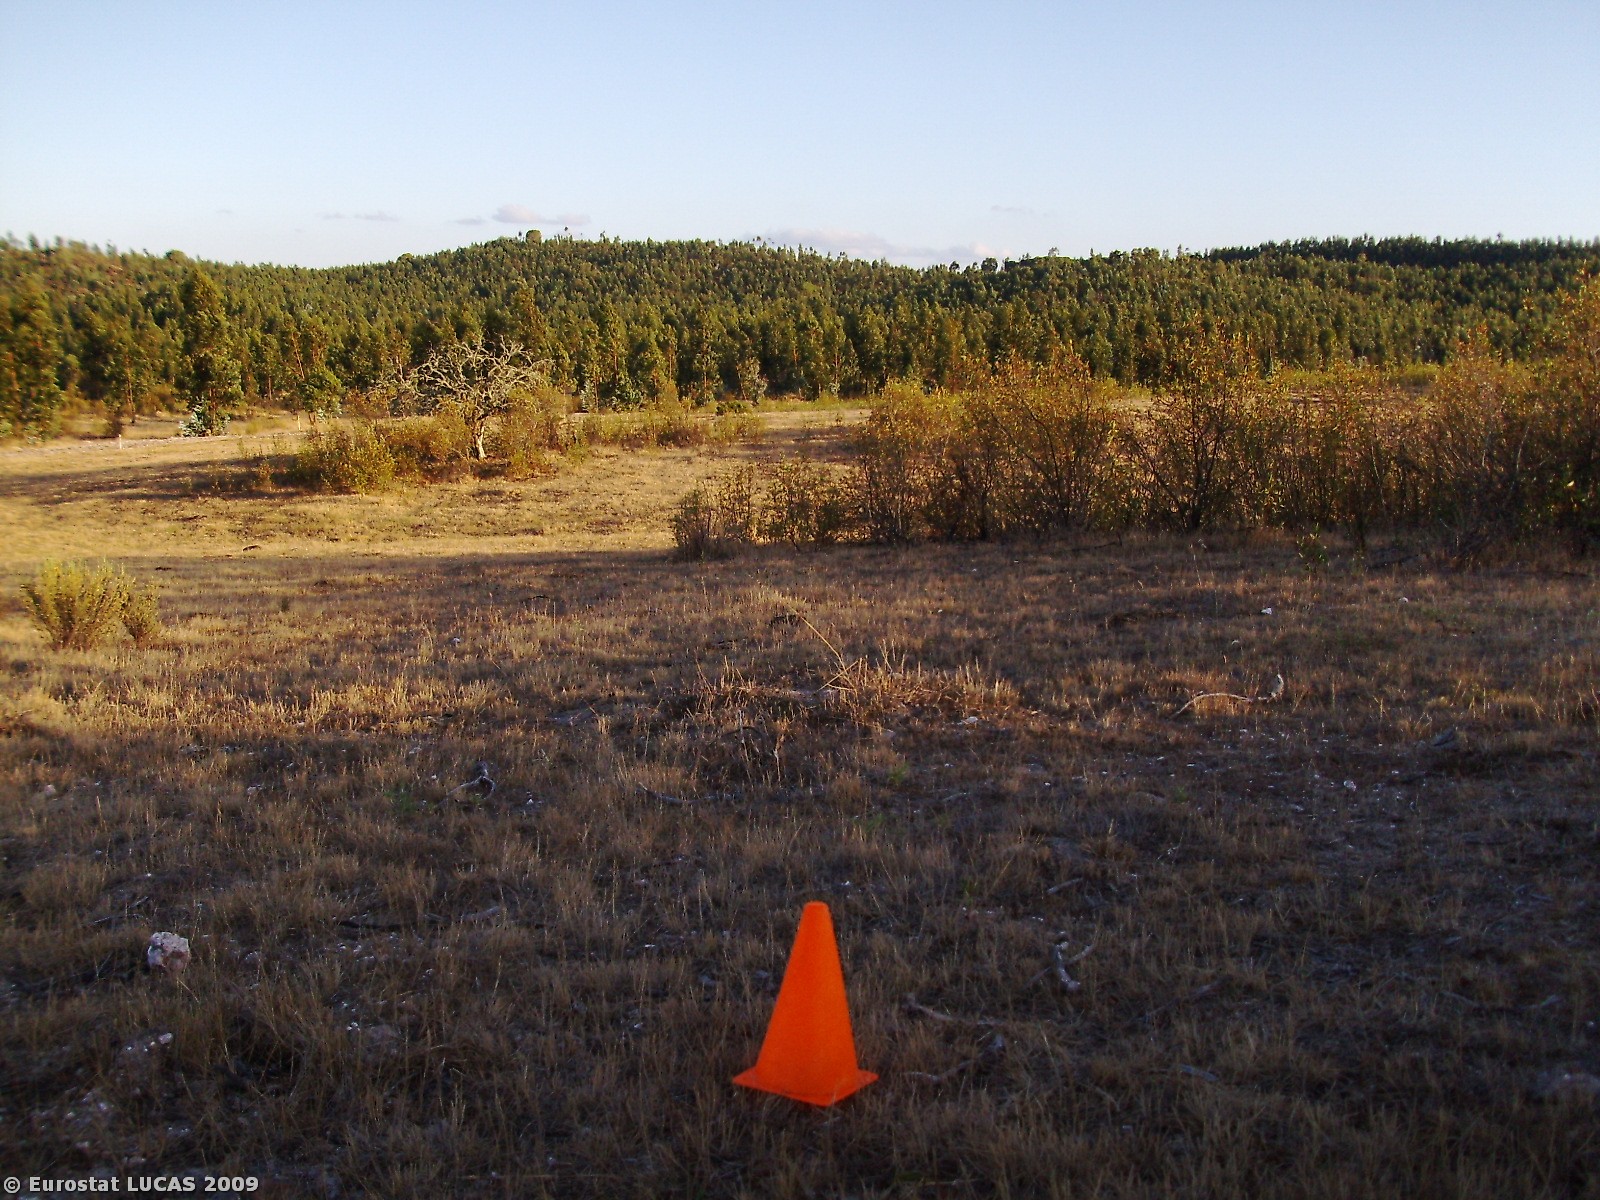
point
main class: Grassland
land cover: Spontaneously vegetated surfaces
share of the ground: 50 - 75 %
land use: Fallow land
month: June
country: PT
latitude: 38.1046
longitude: -8.4854
